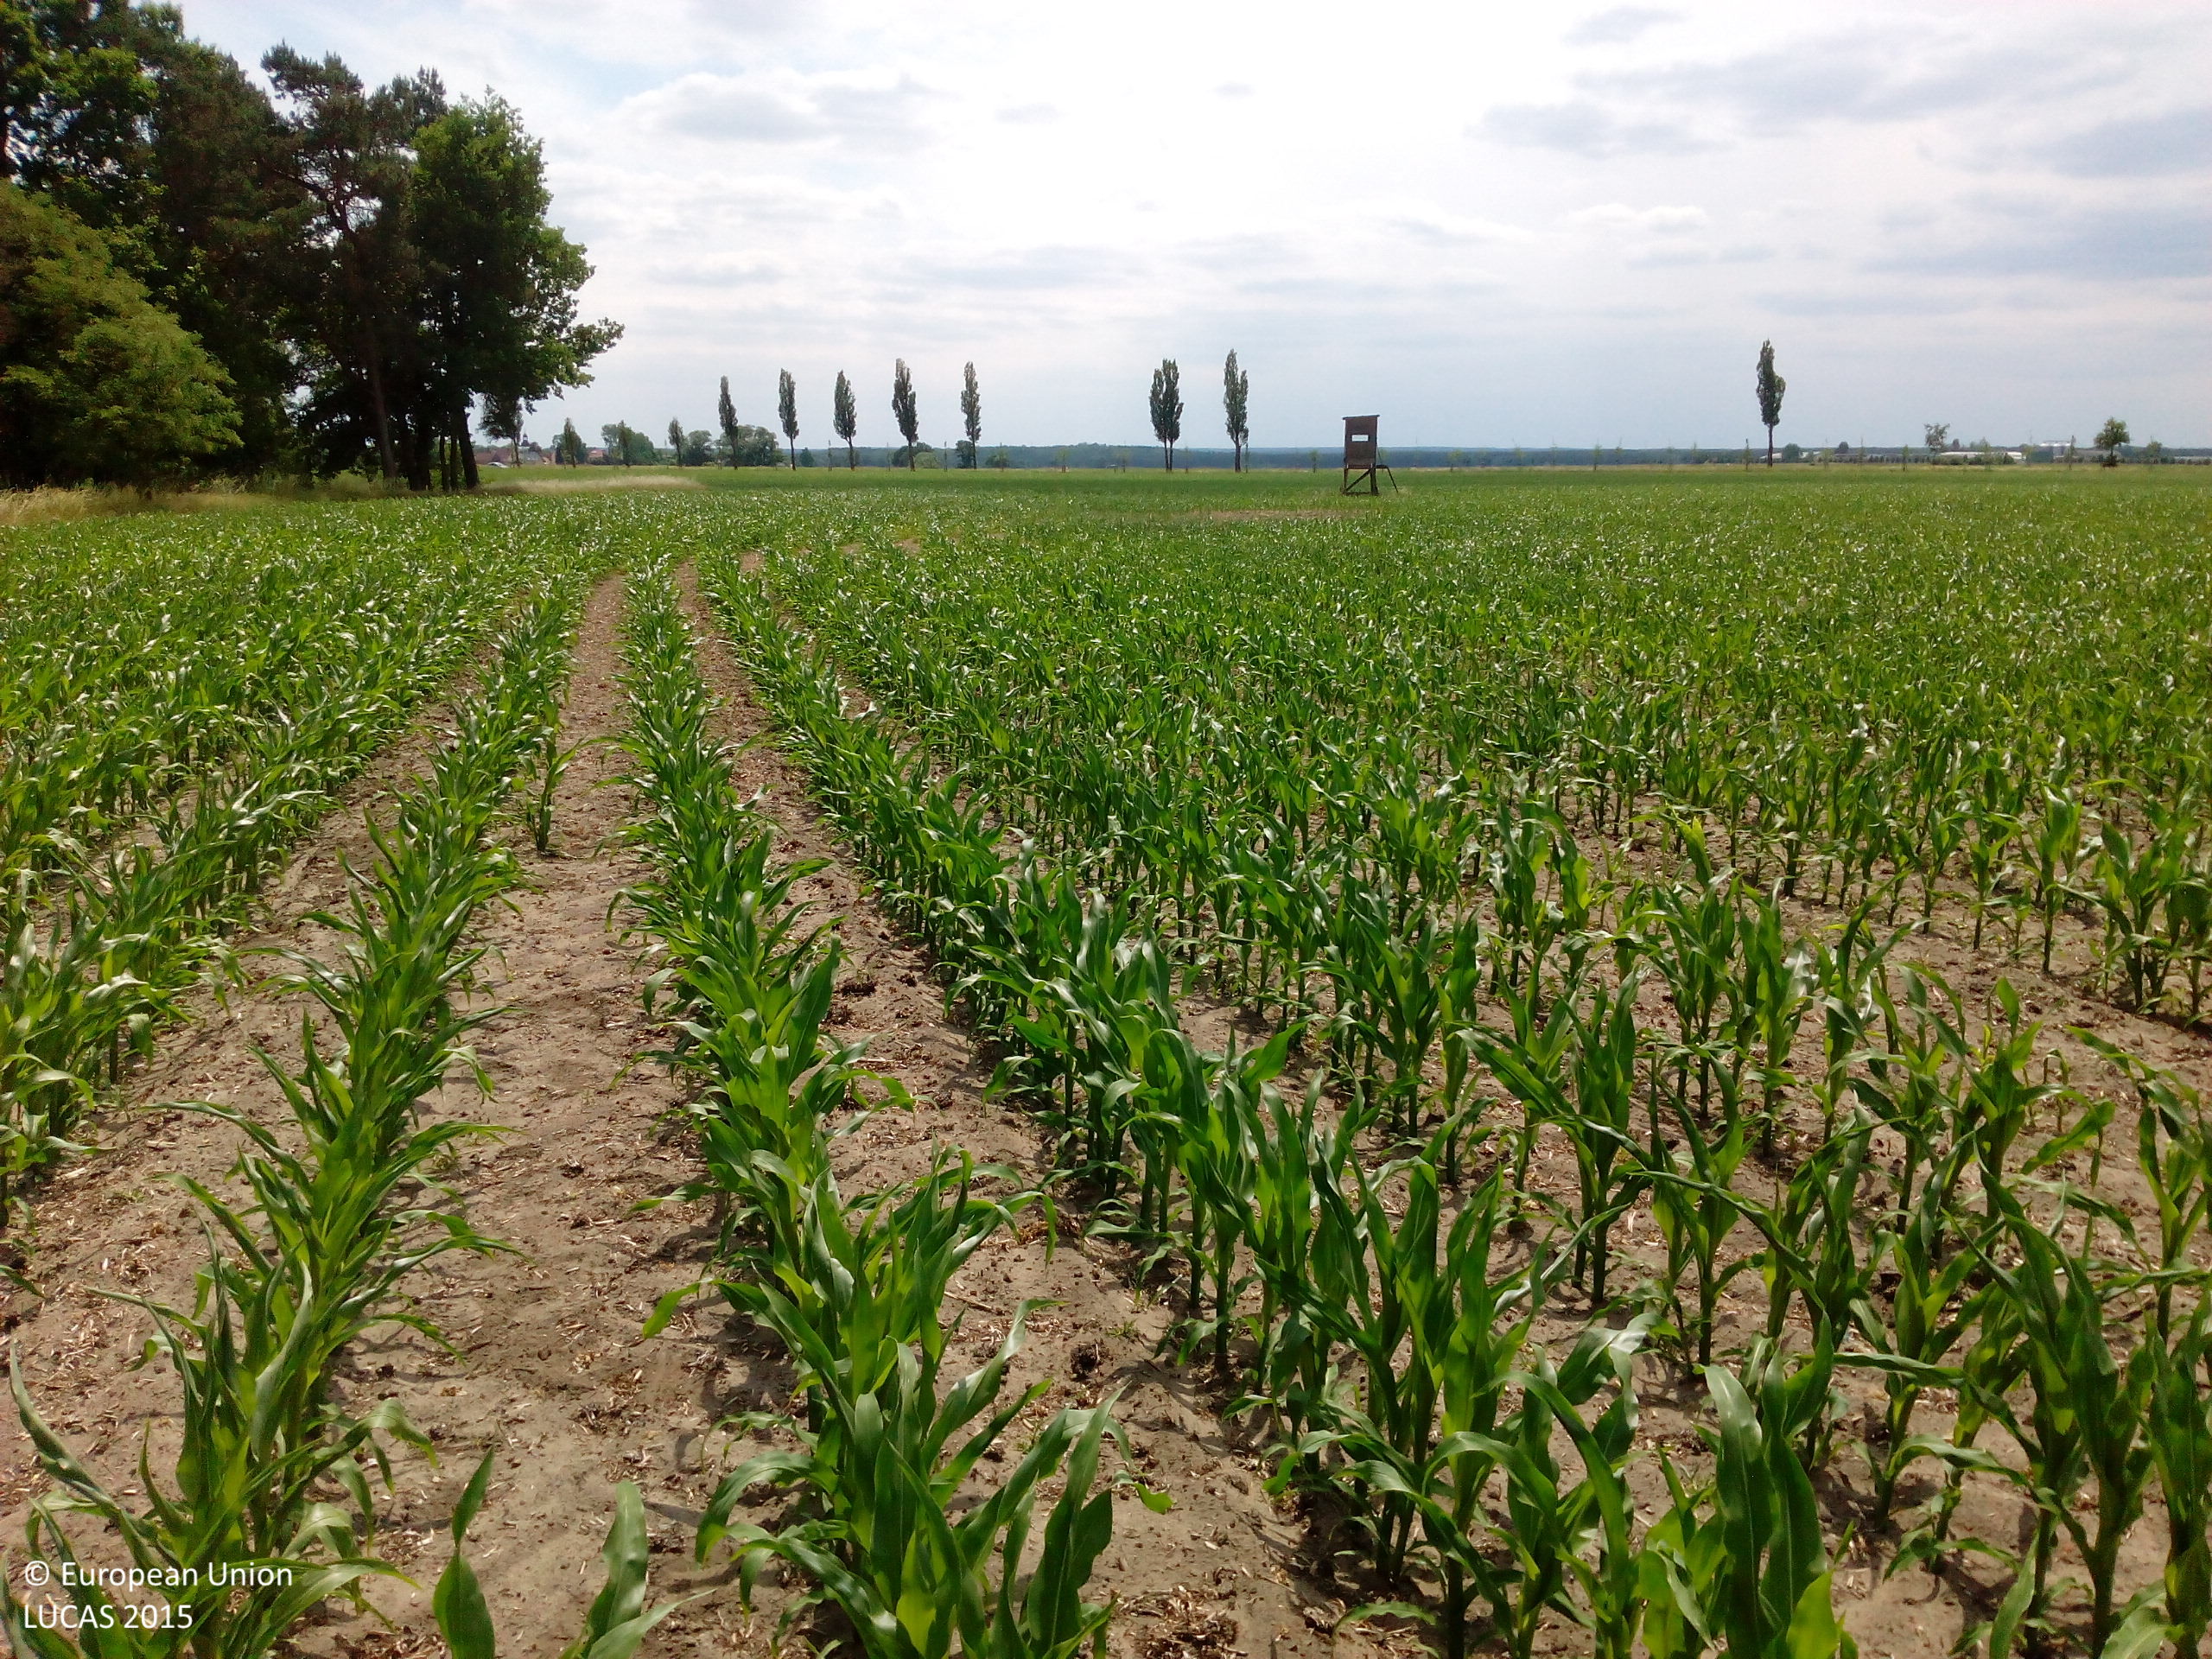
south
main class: Cropland
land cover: Maize
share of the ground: > 75 %
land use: Agriculture (excluding fallow land and kitchen gardens)
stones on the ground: < 10 %
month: June
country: DE
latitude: 51.8282
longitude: 12.5680
